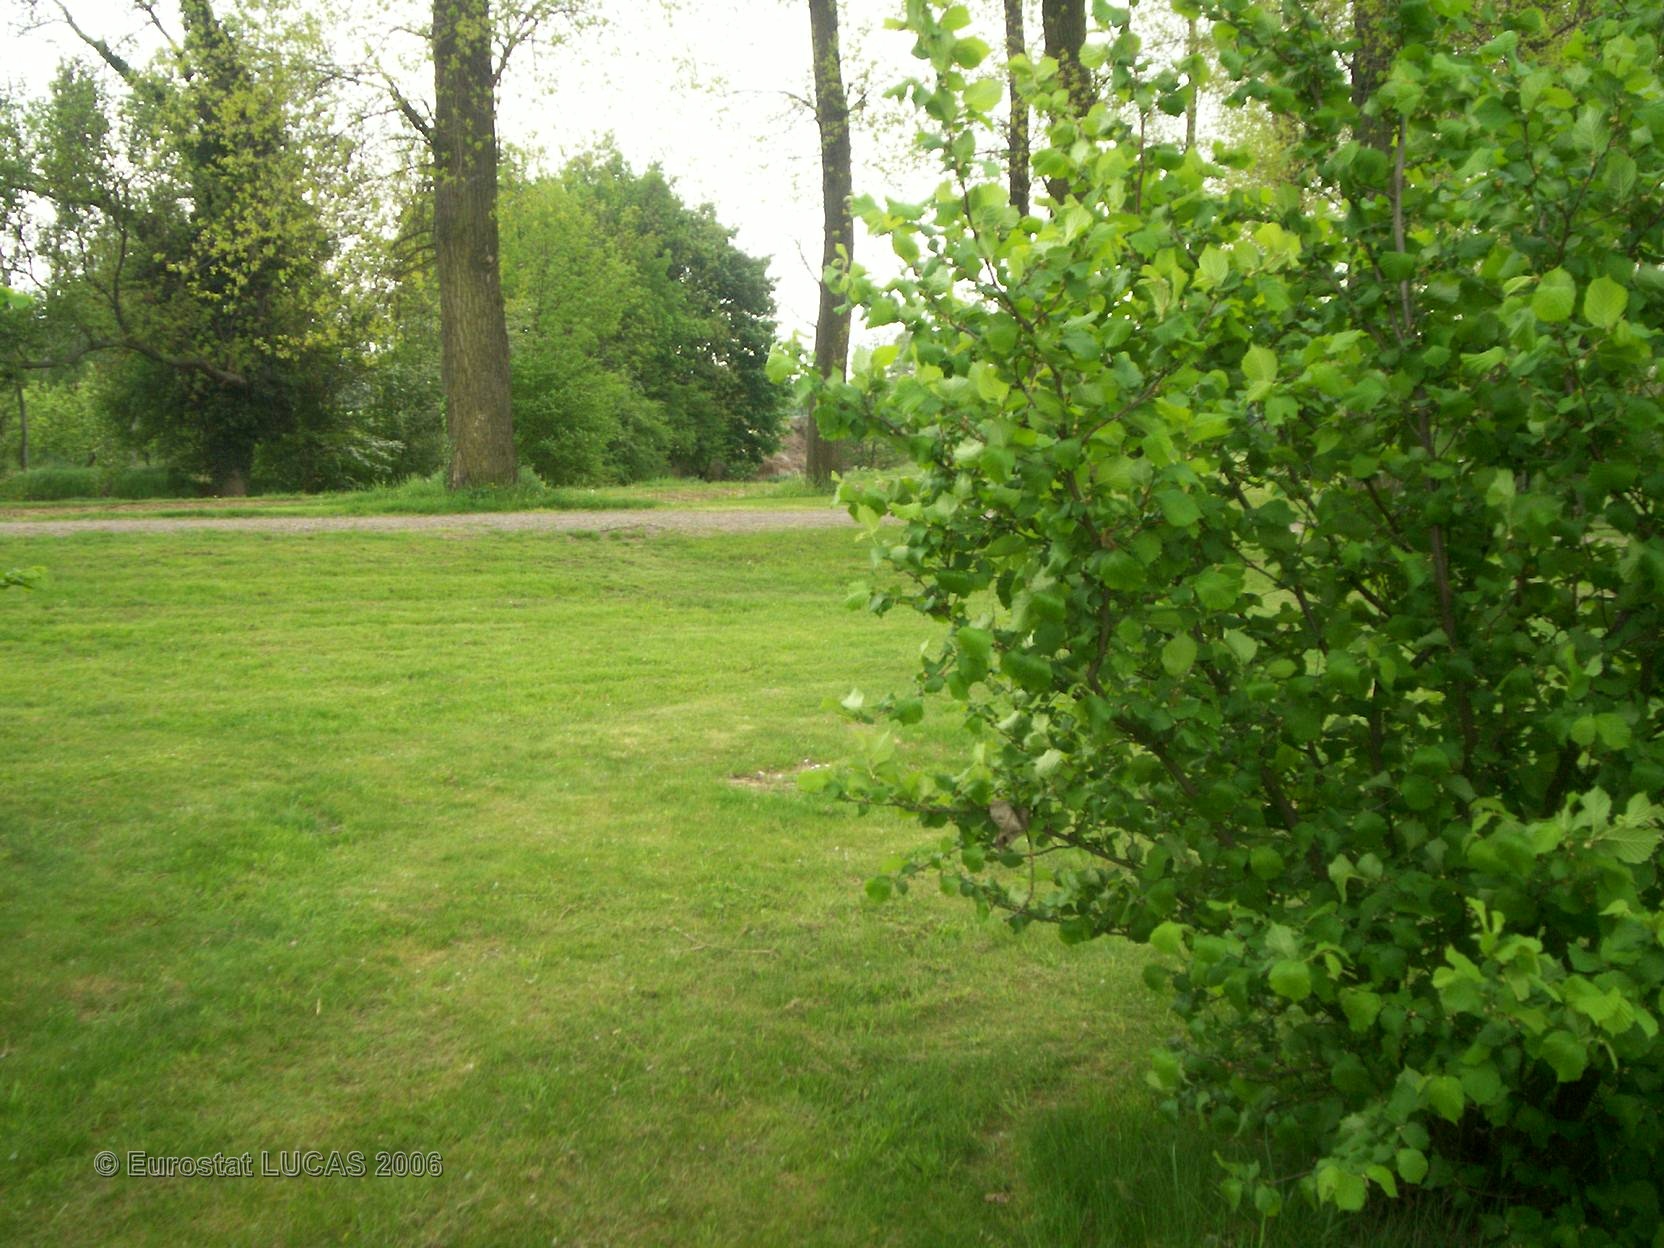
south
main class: Grassland
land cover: Grassland with sparse tree/shrub cover
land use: Amenities, museums, leisure
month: April
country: FR
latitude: 45.3407
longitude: 4.8106
